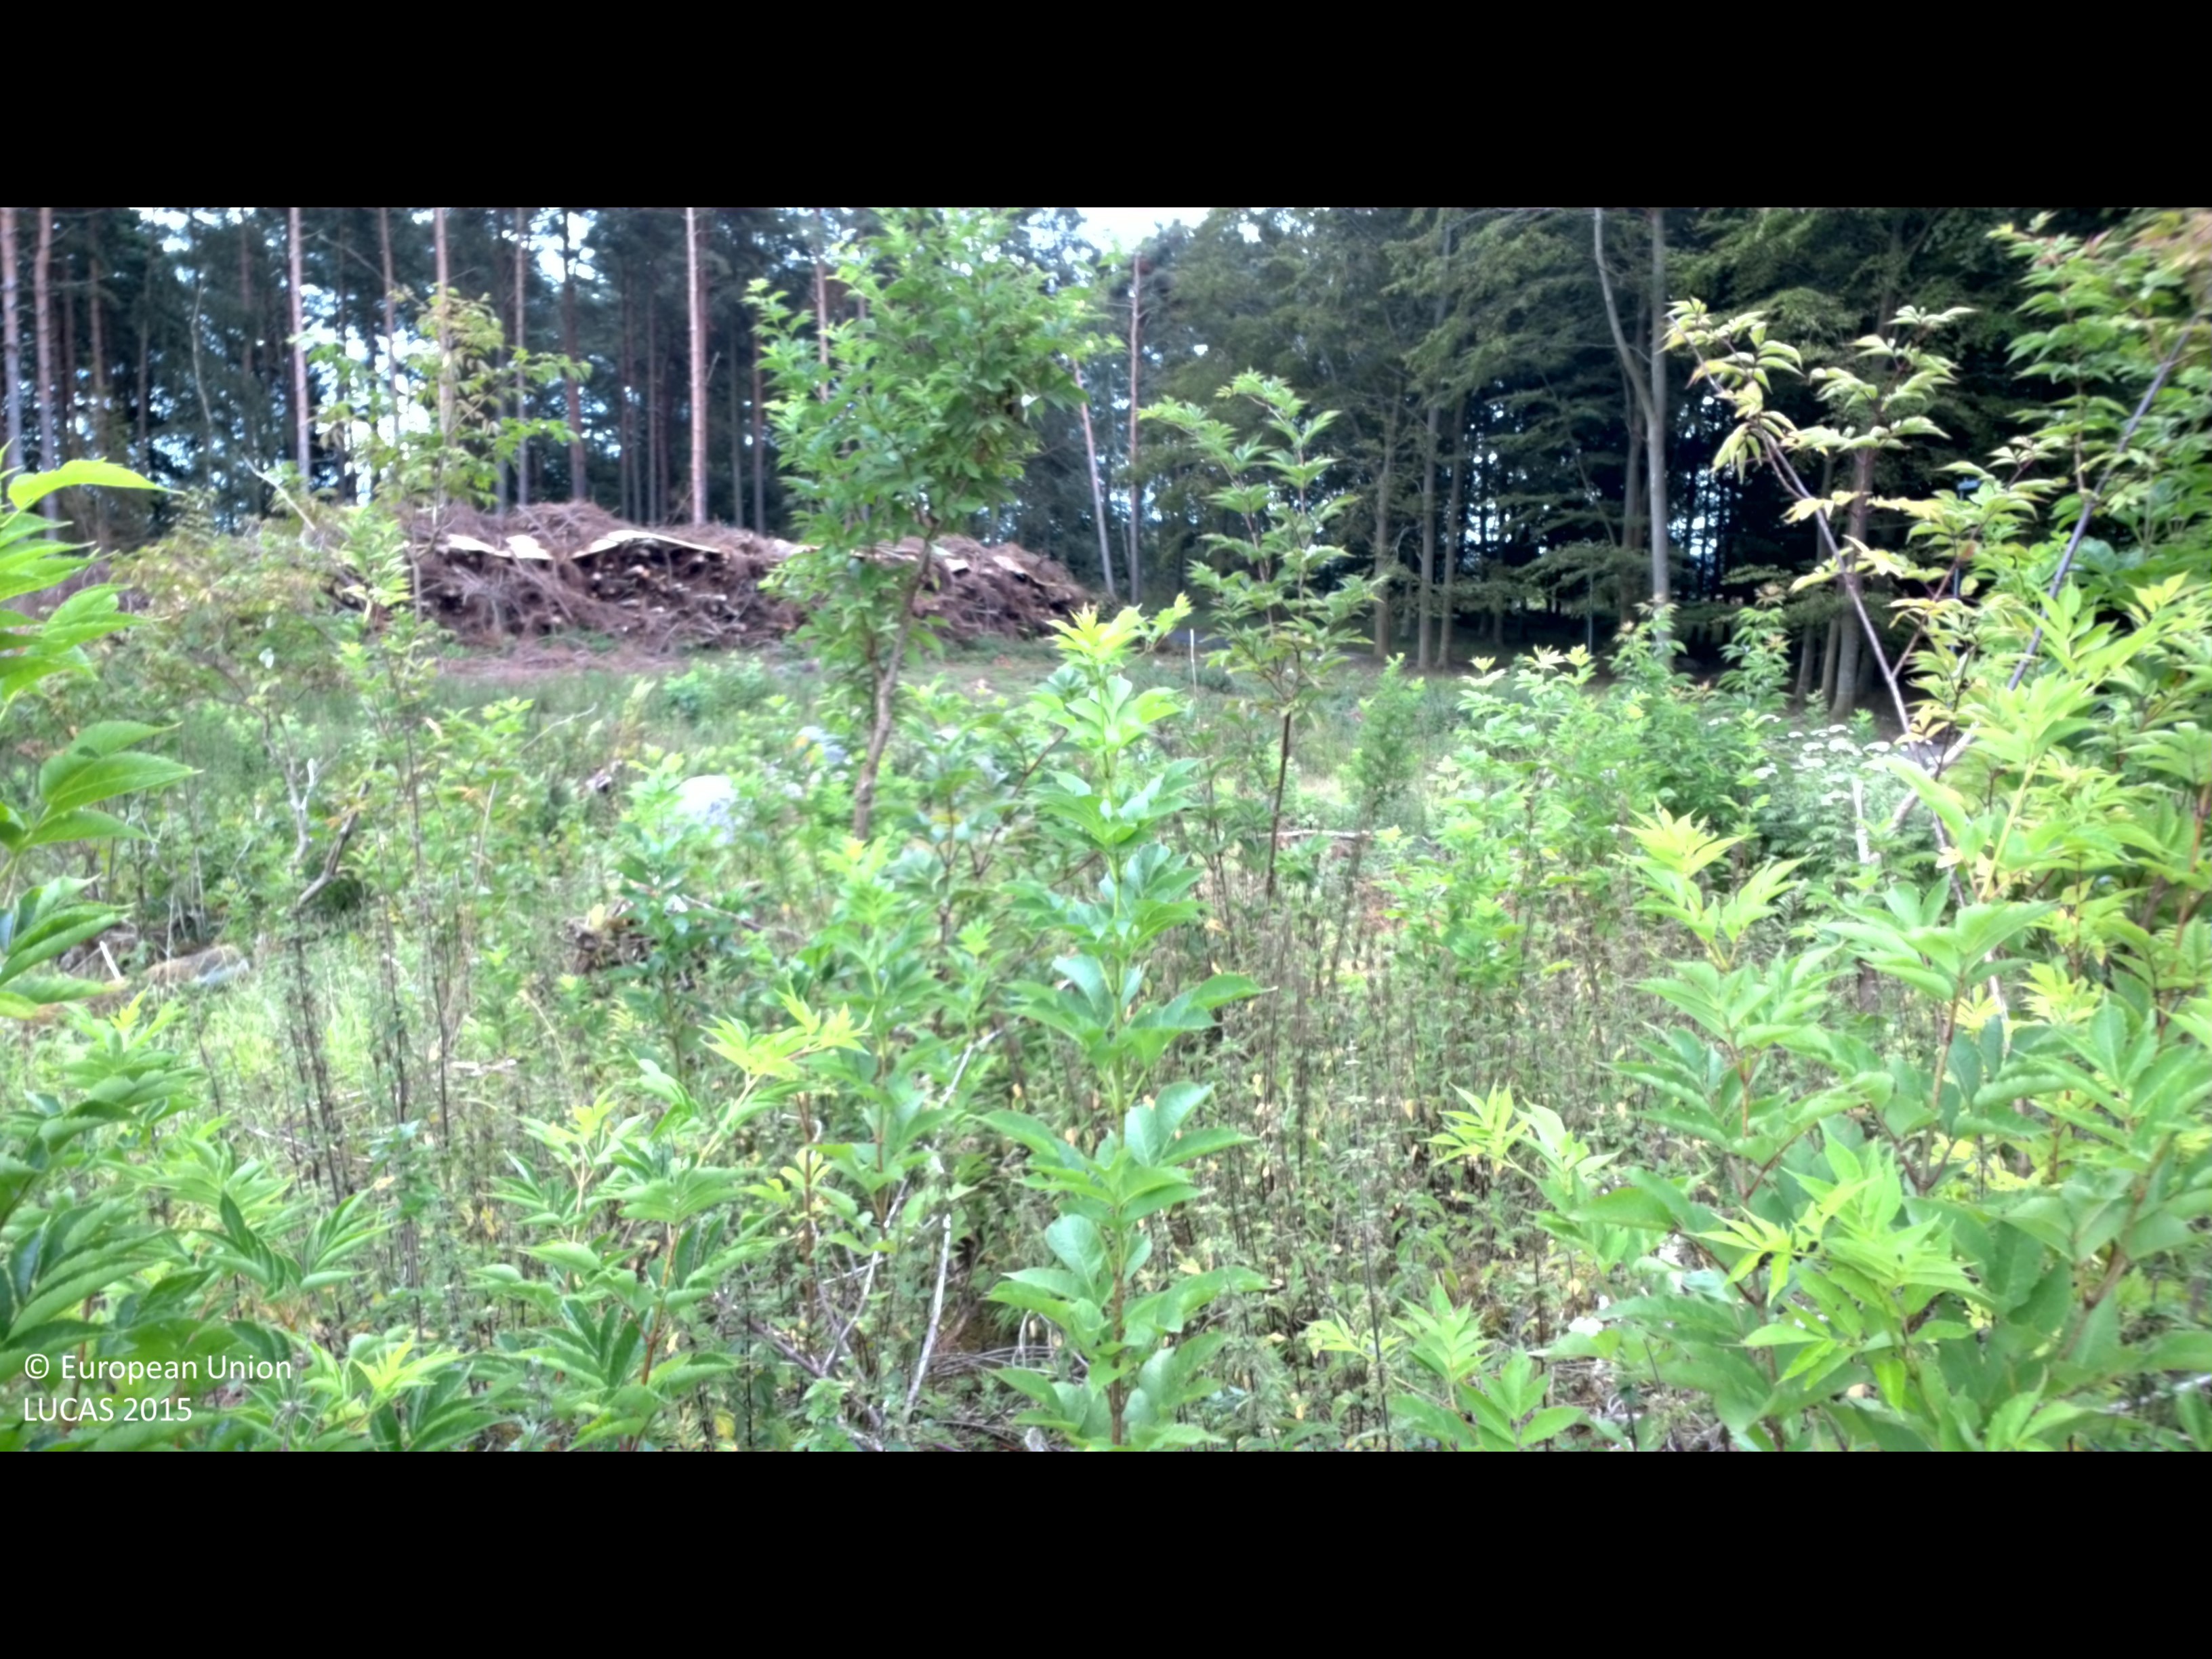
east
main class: Shrubland
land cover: Shrubland without tree cover
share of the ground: > 75 %
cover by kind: shrubs 65 %, herbaceous plants 35 %
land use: Forestry
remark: Clear cut
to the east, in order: Shrubland without tree cover; Pine dominated coniferous woodland; Tracks; Pine dominated mixed woodland; Tracks; Pine dominated mixed woodland; Artificial constructions in urban areas
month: July
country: SE
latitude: 55.8911
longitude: 14.0114
